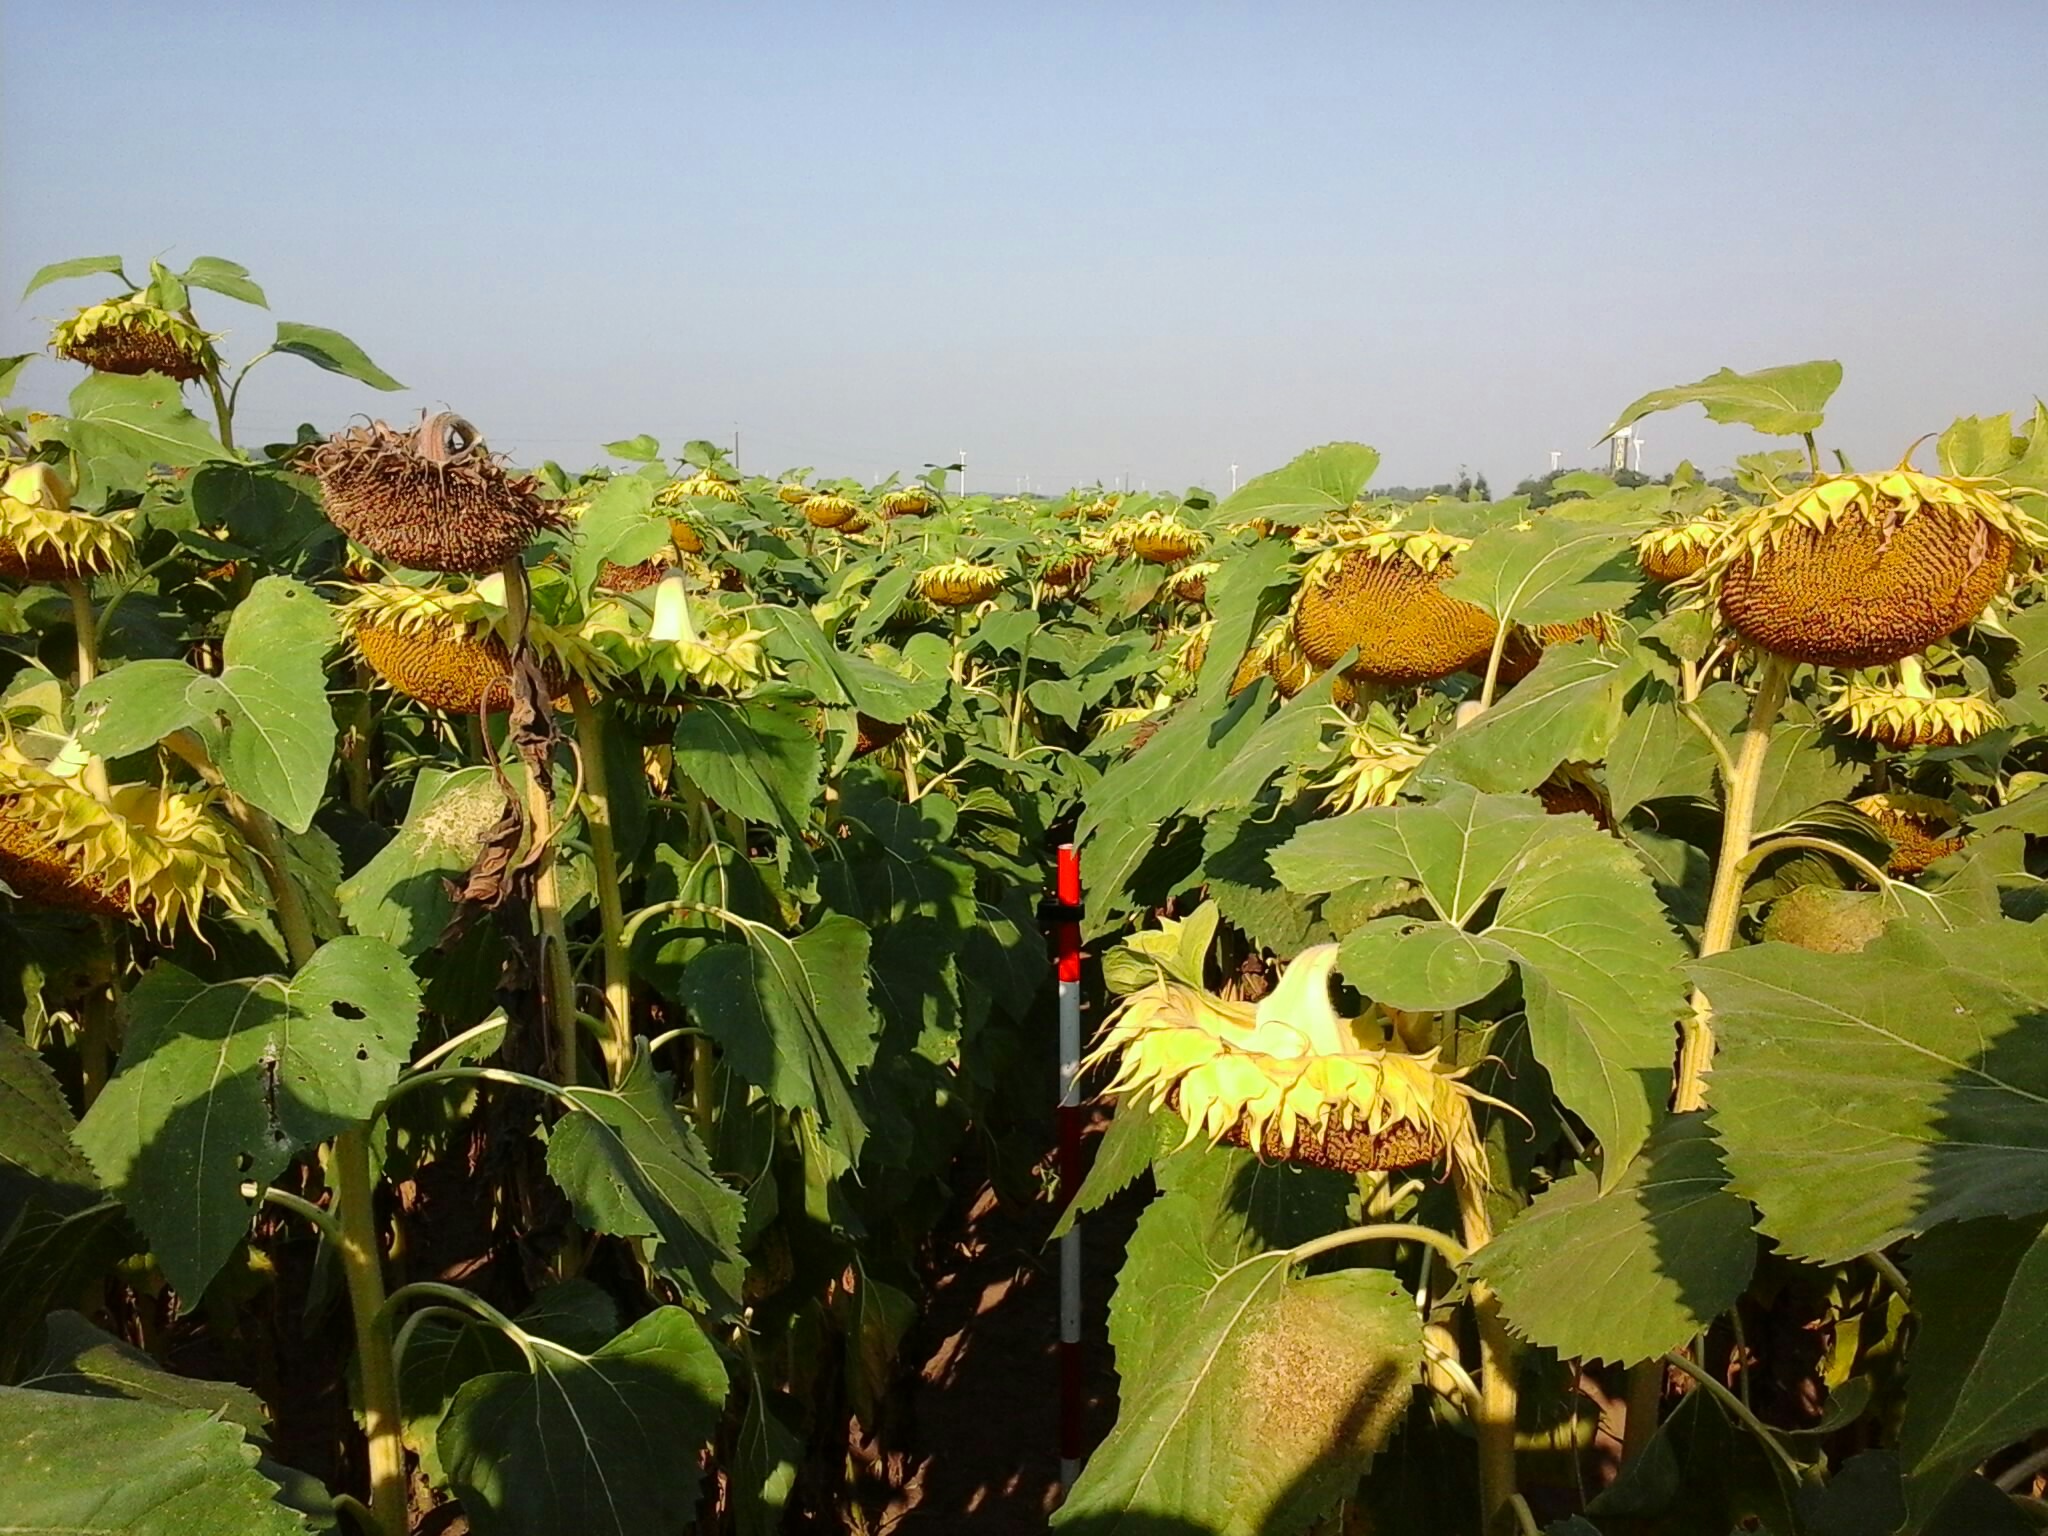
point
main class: Cropland
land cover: Sunflower
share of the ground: > 75 %
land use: Agriculture (excluding fallow land and kitchen gardens)
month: August
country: HU
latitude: 47.6801
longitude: 17.9903
